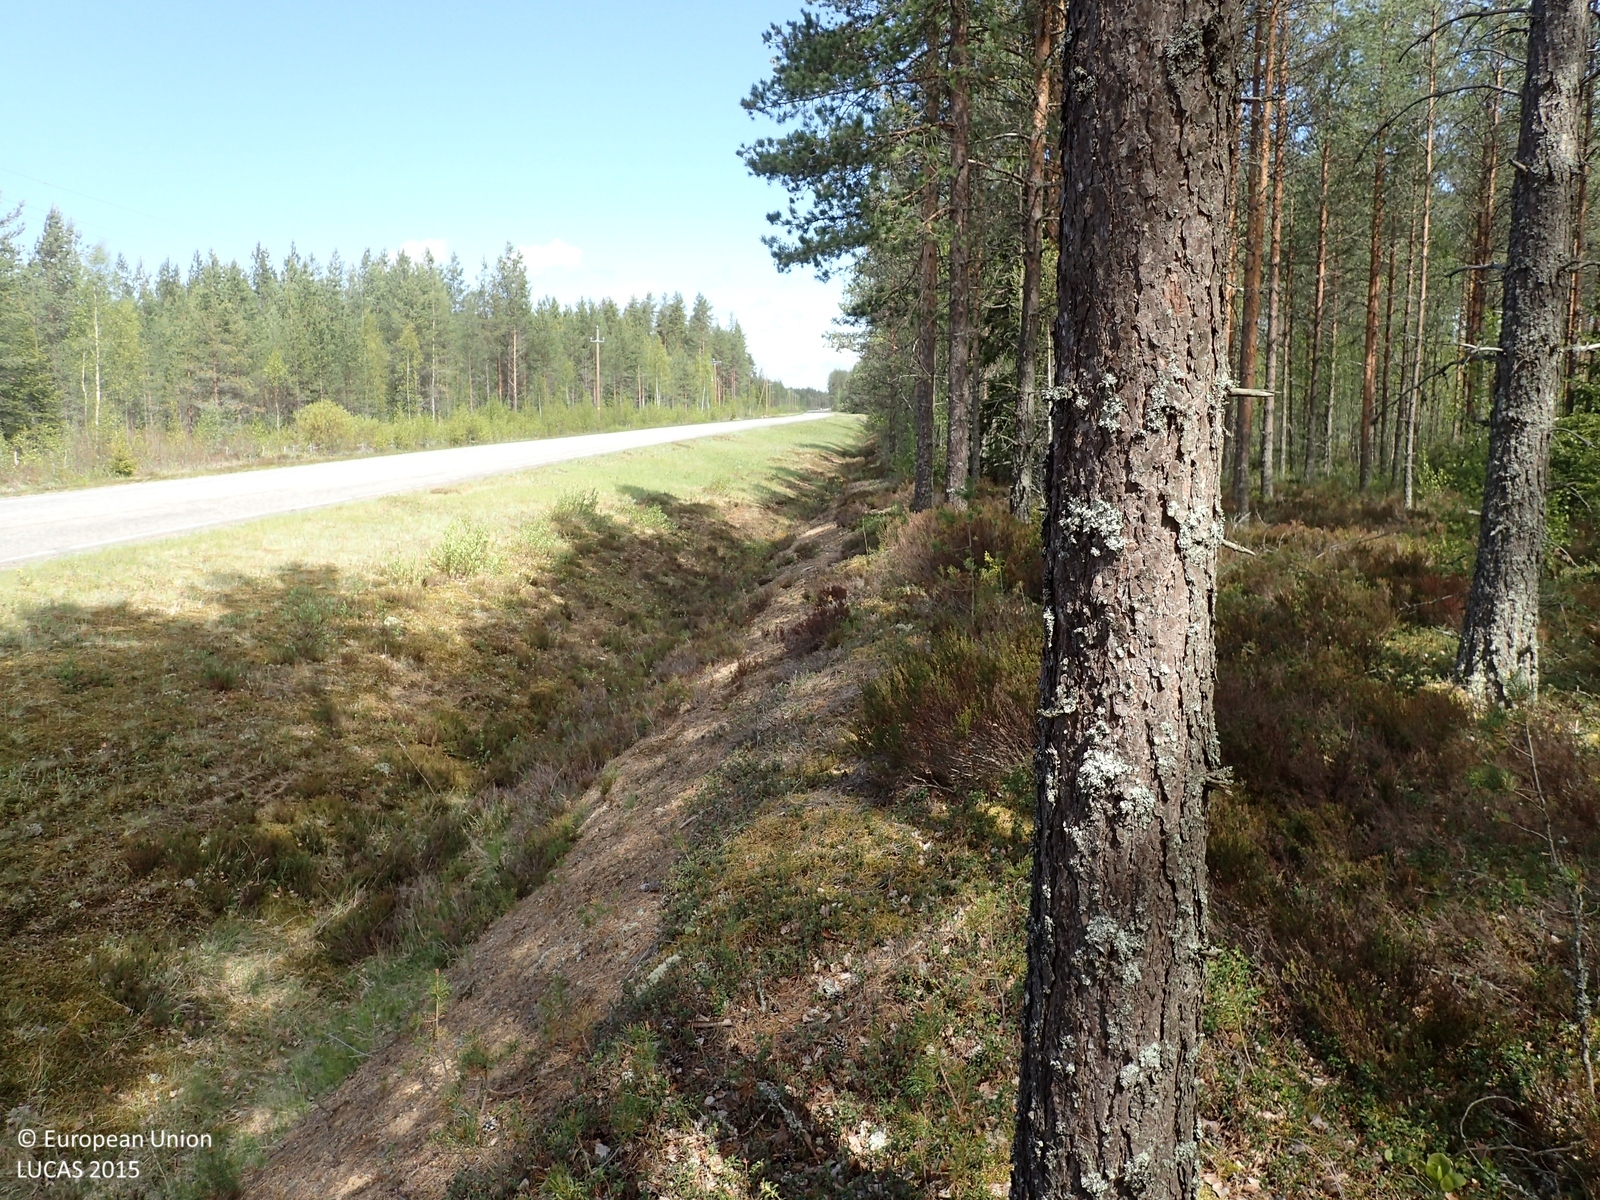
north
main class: Woodland
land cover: Pine dominated coniferous woodland
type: boreal forest
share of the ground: > 75 %
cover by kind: coniferous forest trees 65 %, shrubs 20 %, broadleaved forest trees 10 %, lichens and mosses 5 %
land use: Forestry
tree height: > 5 m
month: June
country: FI
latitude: 62.1798
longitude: 22.2903
